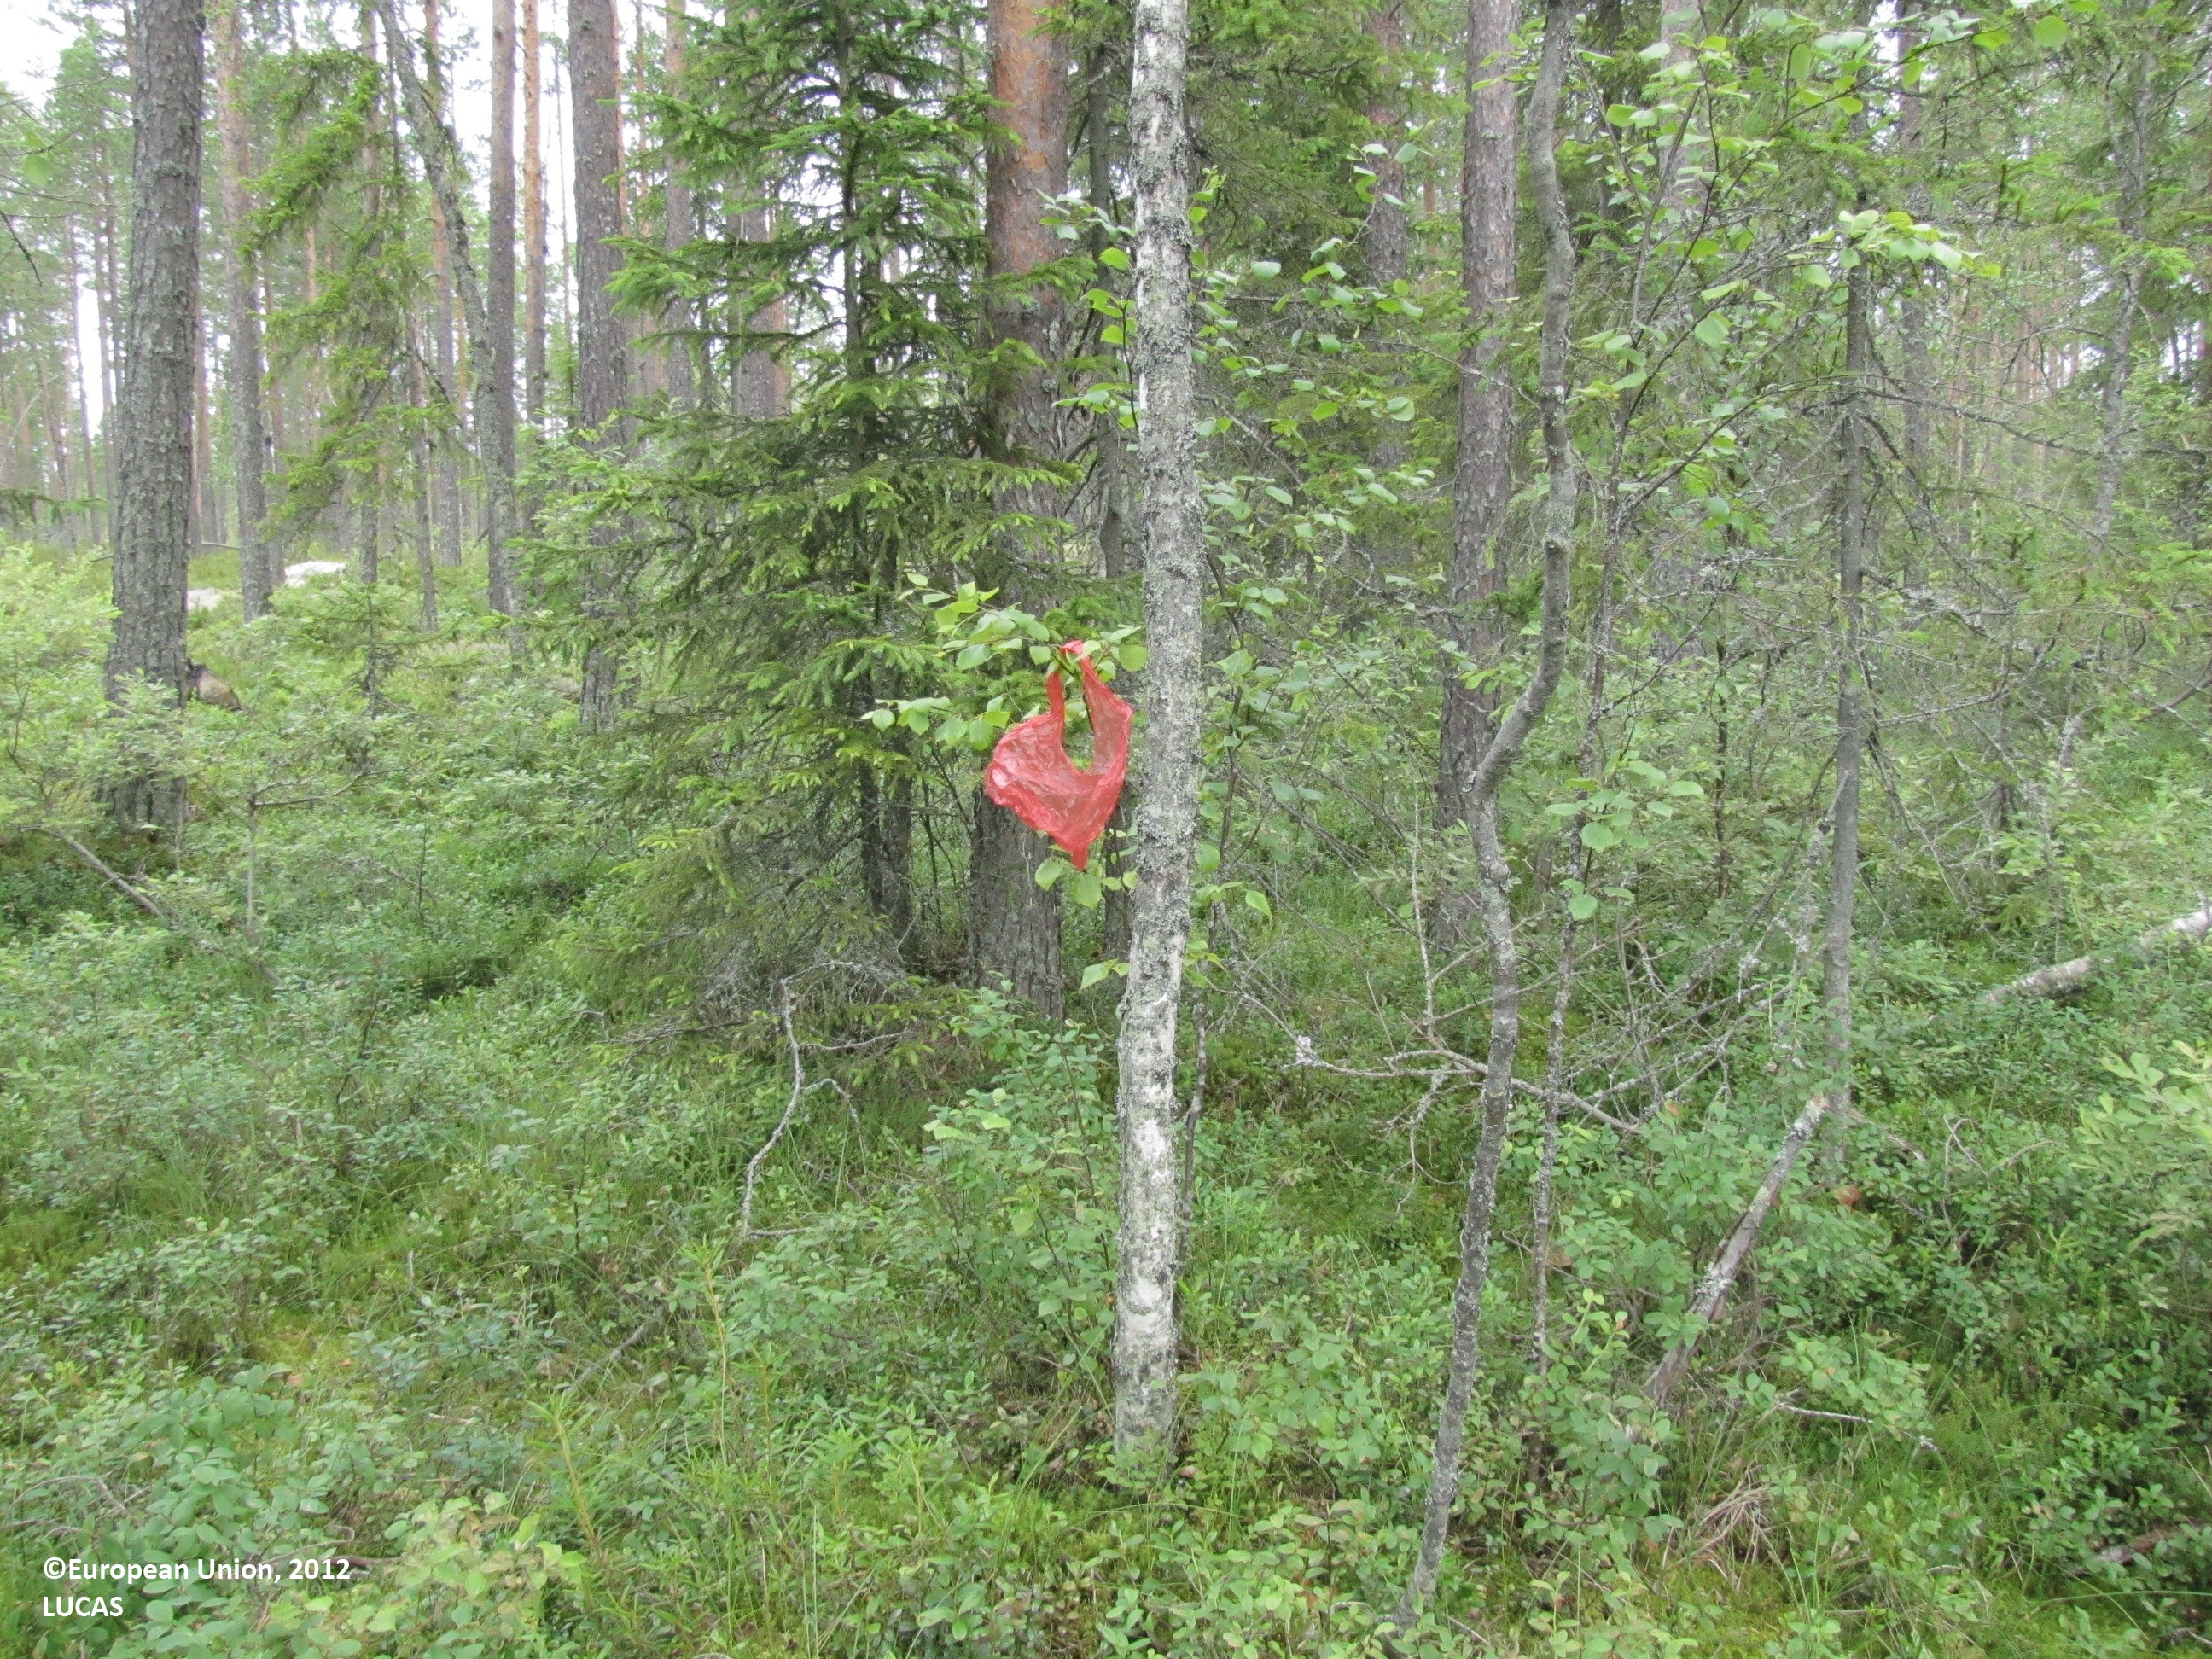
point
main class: Woodland
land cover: Pine dominated coniferous woodland
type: boreal forest
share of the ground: > 75 %
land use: Forestry
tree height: > 5 m
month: July
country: FI
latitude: 62.6631
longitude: 23.4790
